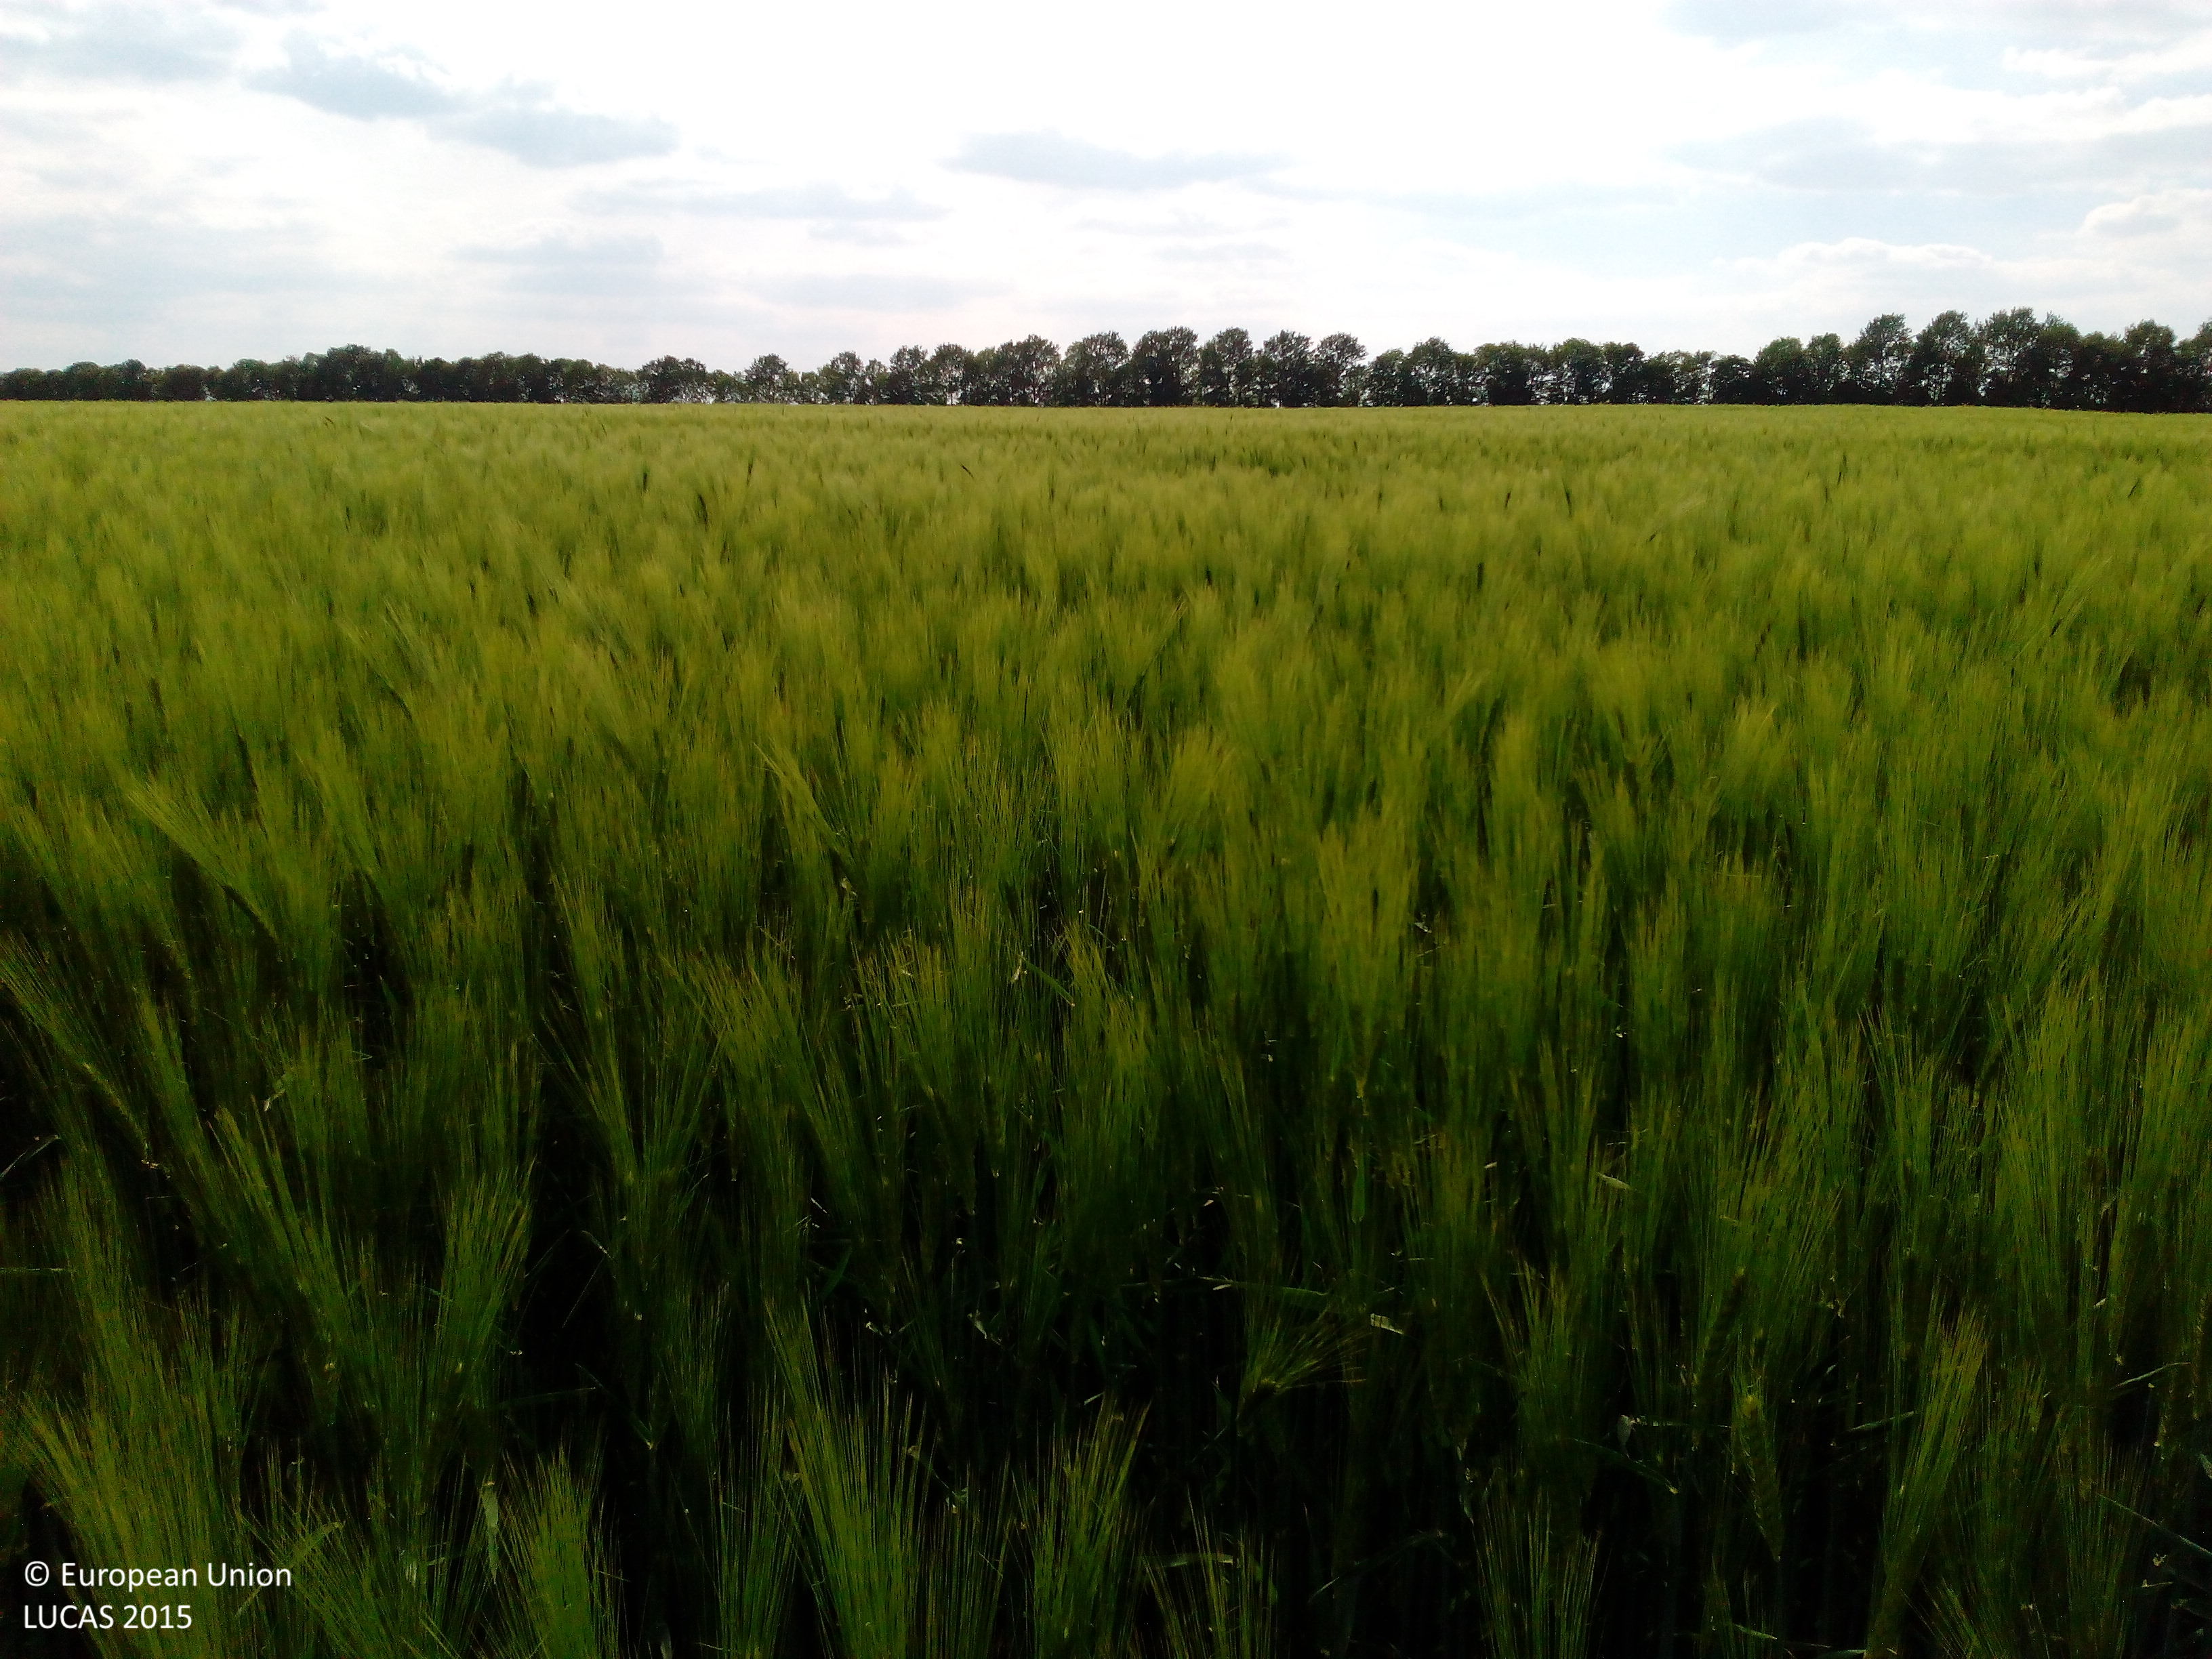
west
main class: Cropland
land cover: Barley
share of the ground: > 75 %
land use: Agriculture (excluding fallow land and kitchen gardens)
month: May
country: DE
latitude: 50.9664
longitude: 11.4378
